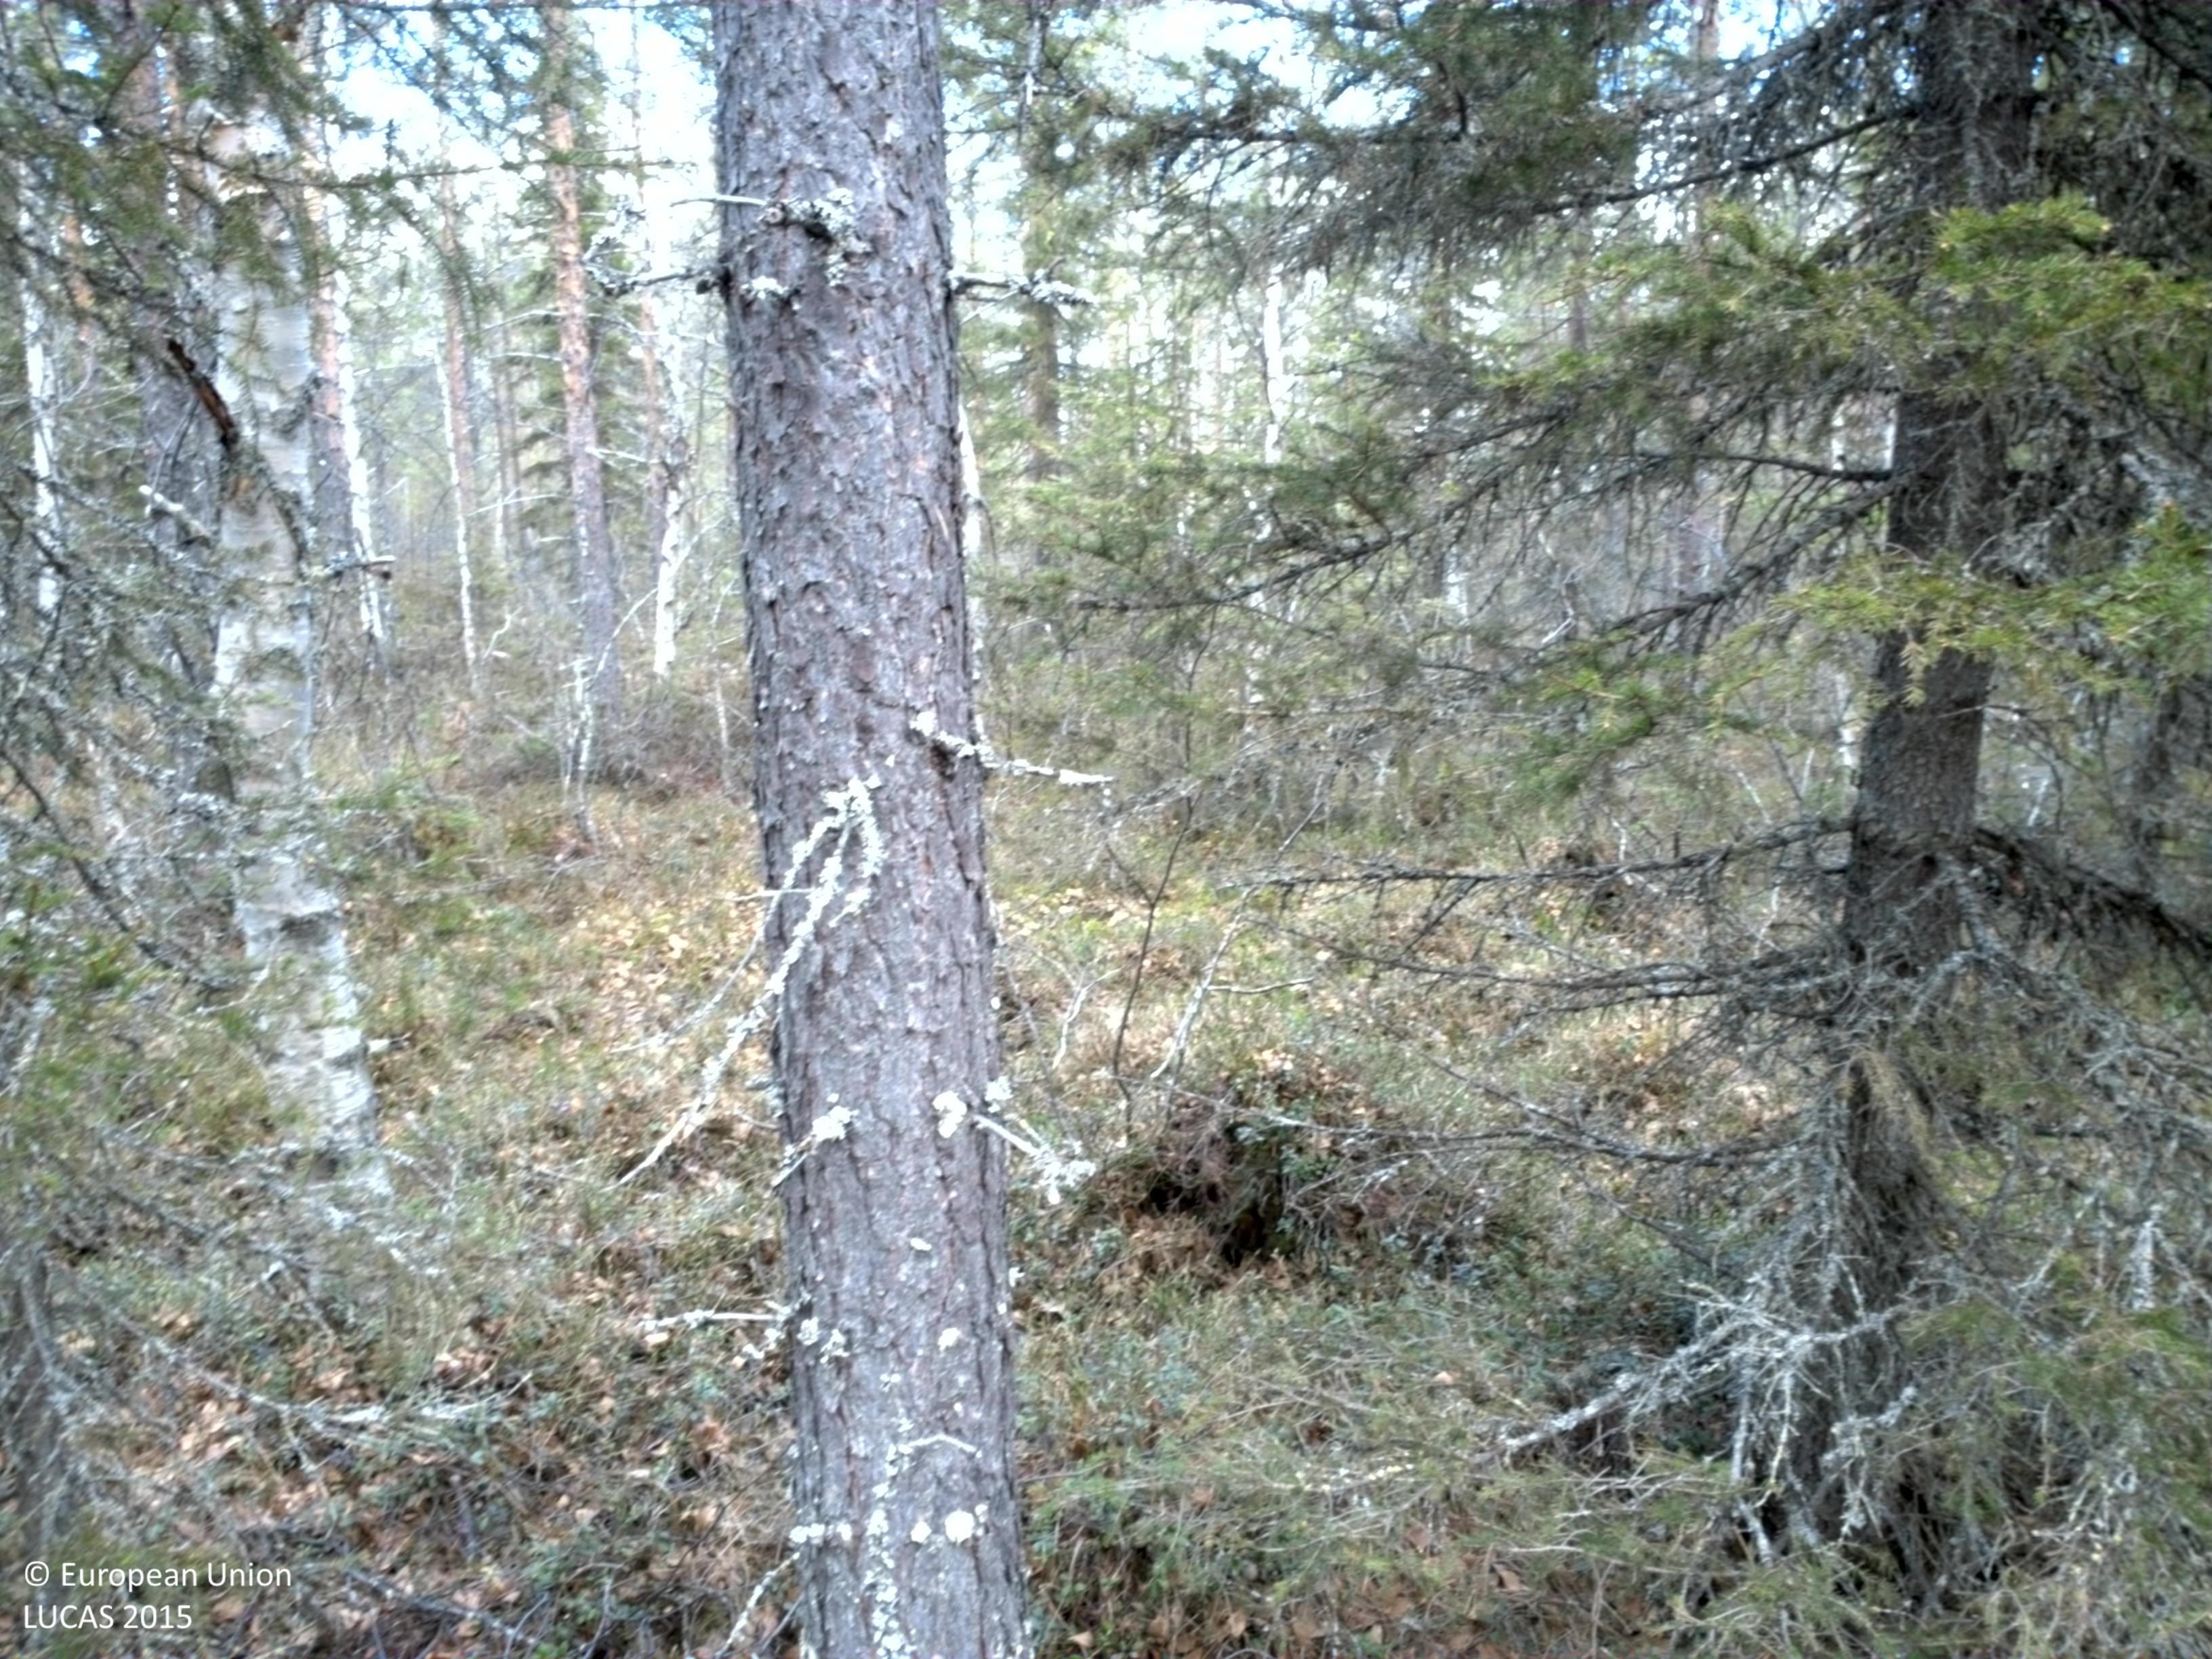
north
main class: Woodland
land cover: Pine dominated mixed woodland
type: boreal forest
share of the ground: > 75 %
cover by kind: coniferous forest trees 60 %, broadleaved forest trees 20 %, shrubs 20 %
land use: Forestry
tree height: > 5 m
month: May
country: SE
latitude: 66.0987
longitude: 23.2800
